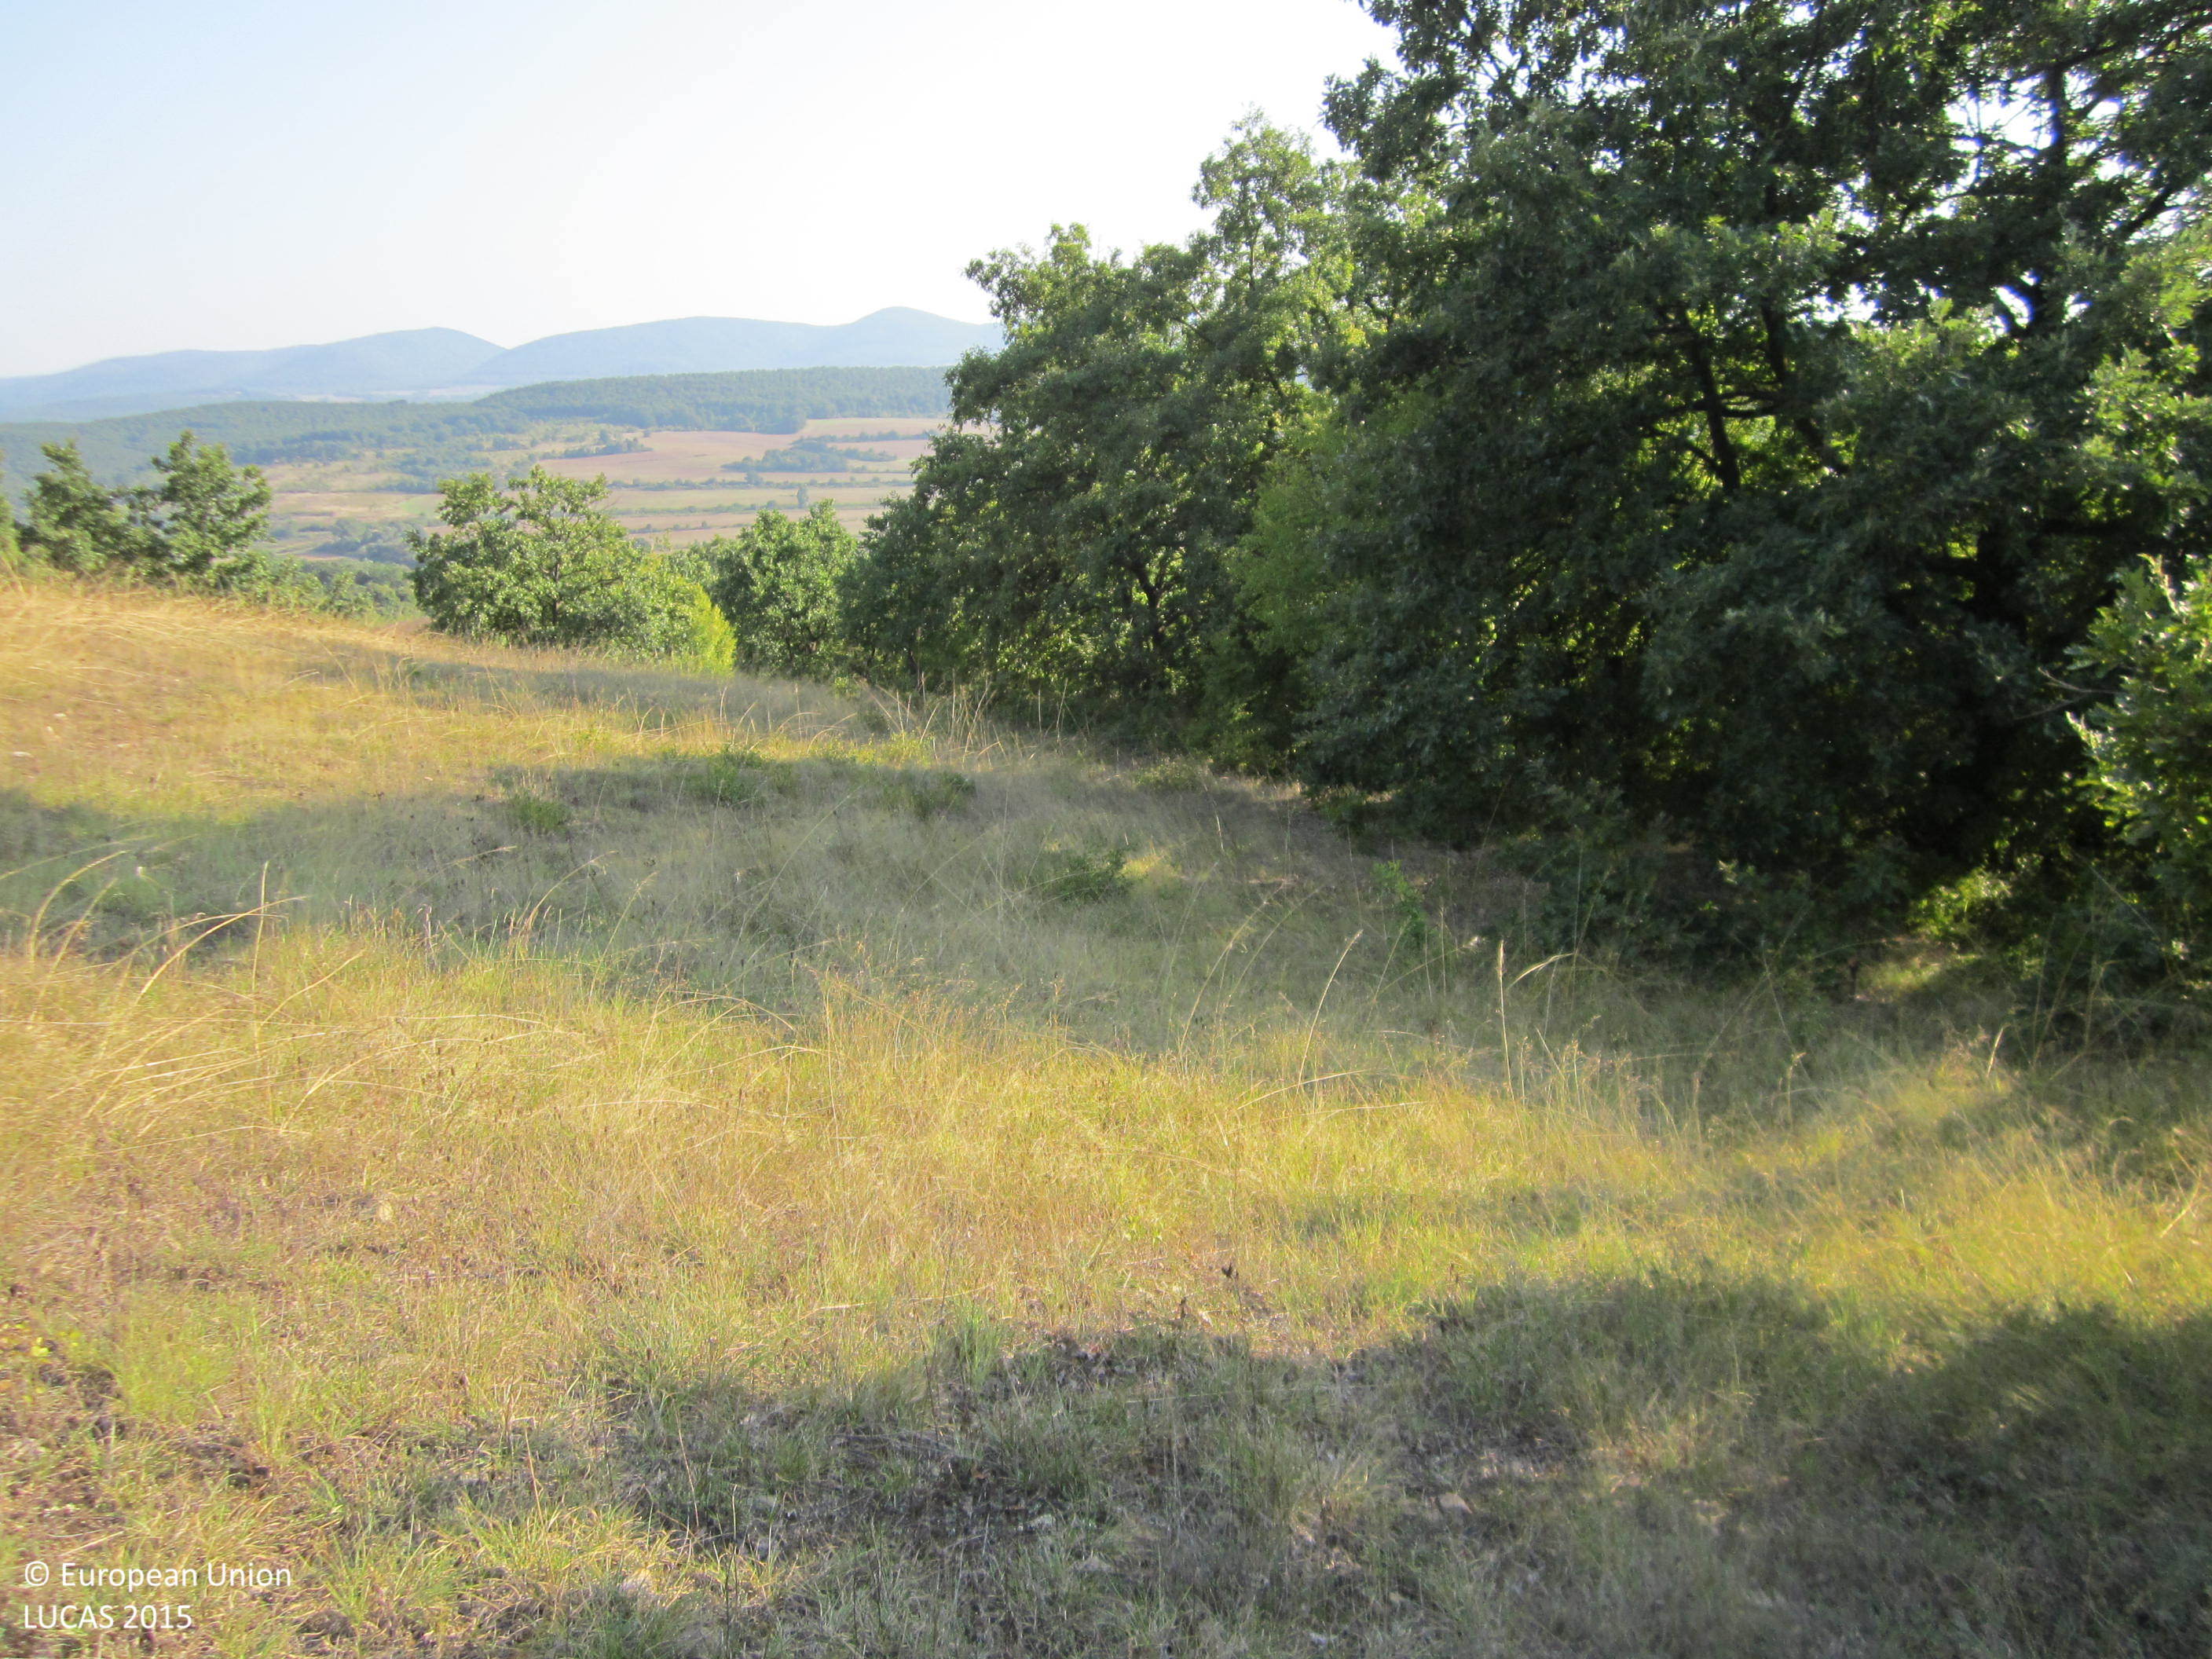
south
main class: Grassland
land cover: Grassland without tree/shrub cover
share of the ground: > 75 %
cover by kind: herbaceous plants 100 %
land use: Agriculture (excluding fallow land and kitchen gardens)
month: September
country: BG
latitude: 42.8474
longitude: 27.0834
